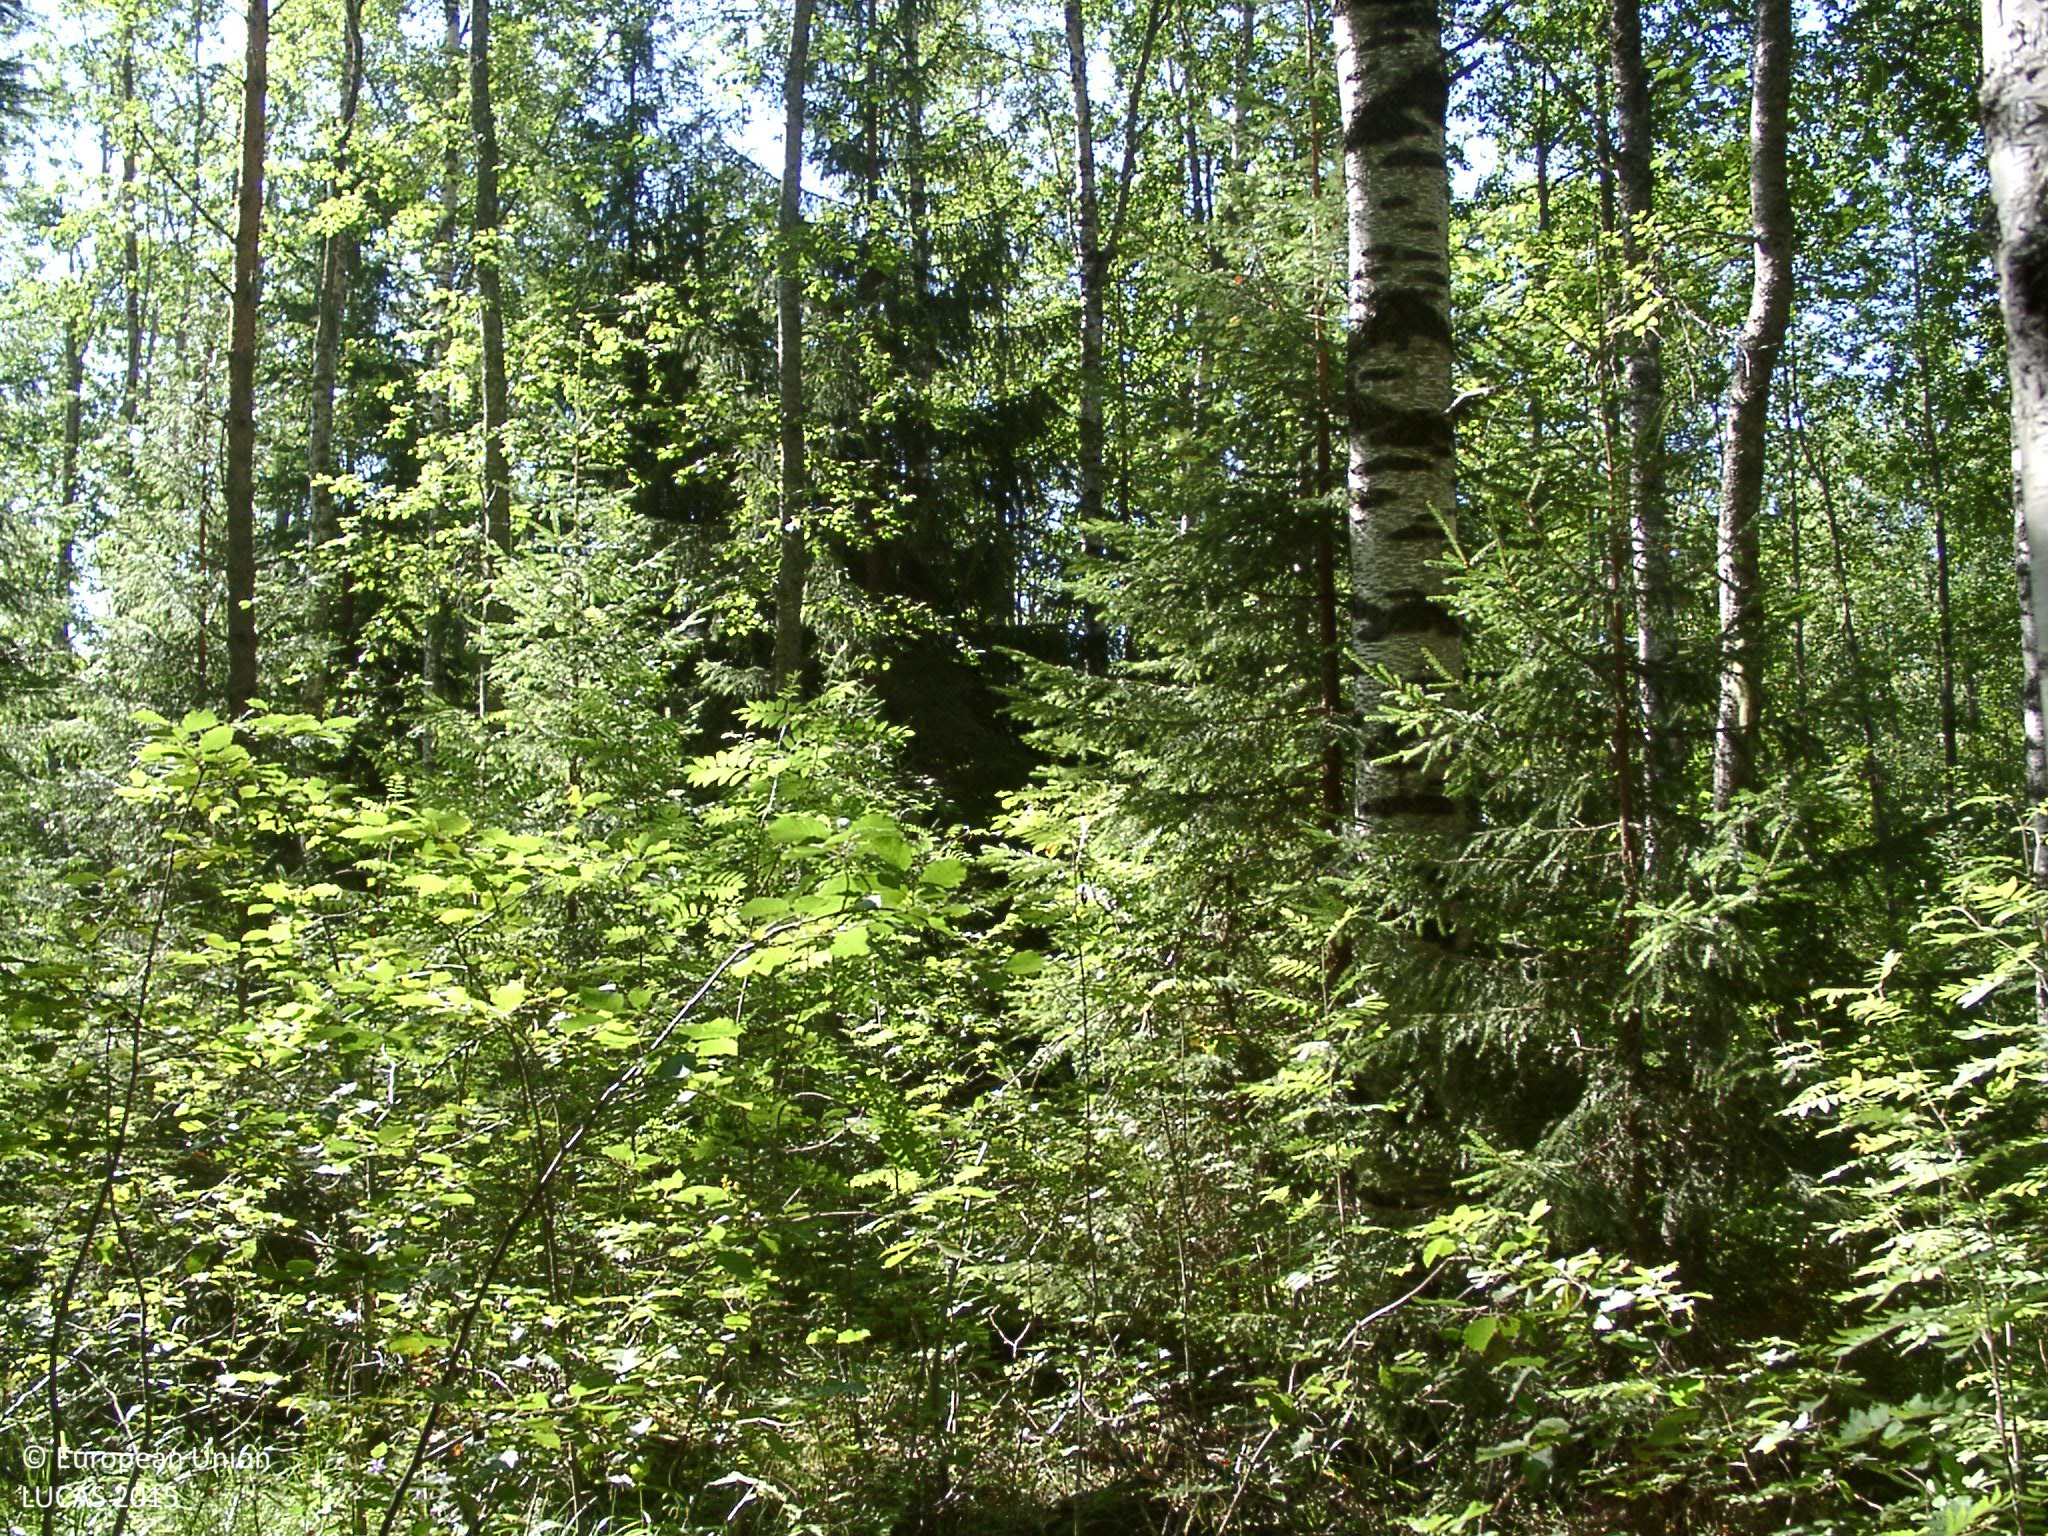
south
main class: Woodland
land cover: Spruce dominated mixed woodland
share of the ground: 50 - 75 %
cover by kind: broadleaved forest trees 50 %, herbaceous plants 25 %, coniferous forest trees 20 %, lichens and mosses 5 %
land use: Forestry
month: August
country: FI
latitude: 62.4034
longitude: 25.2185
